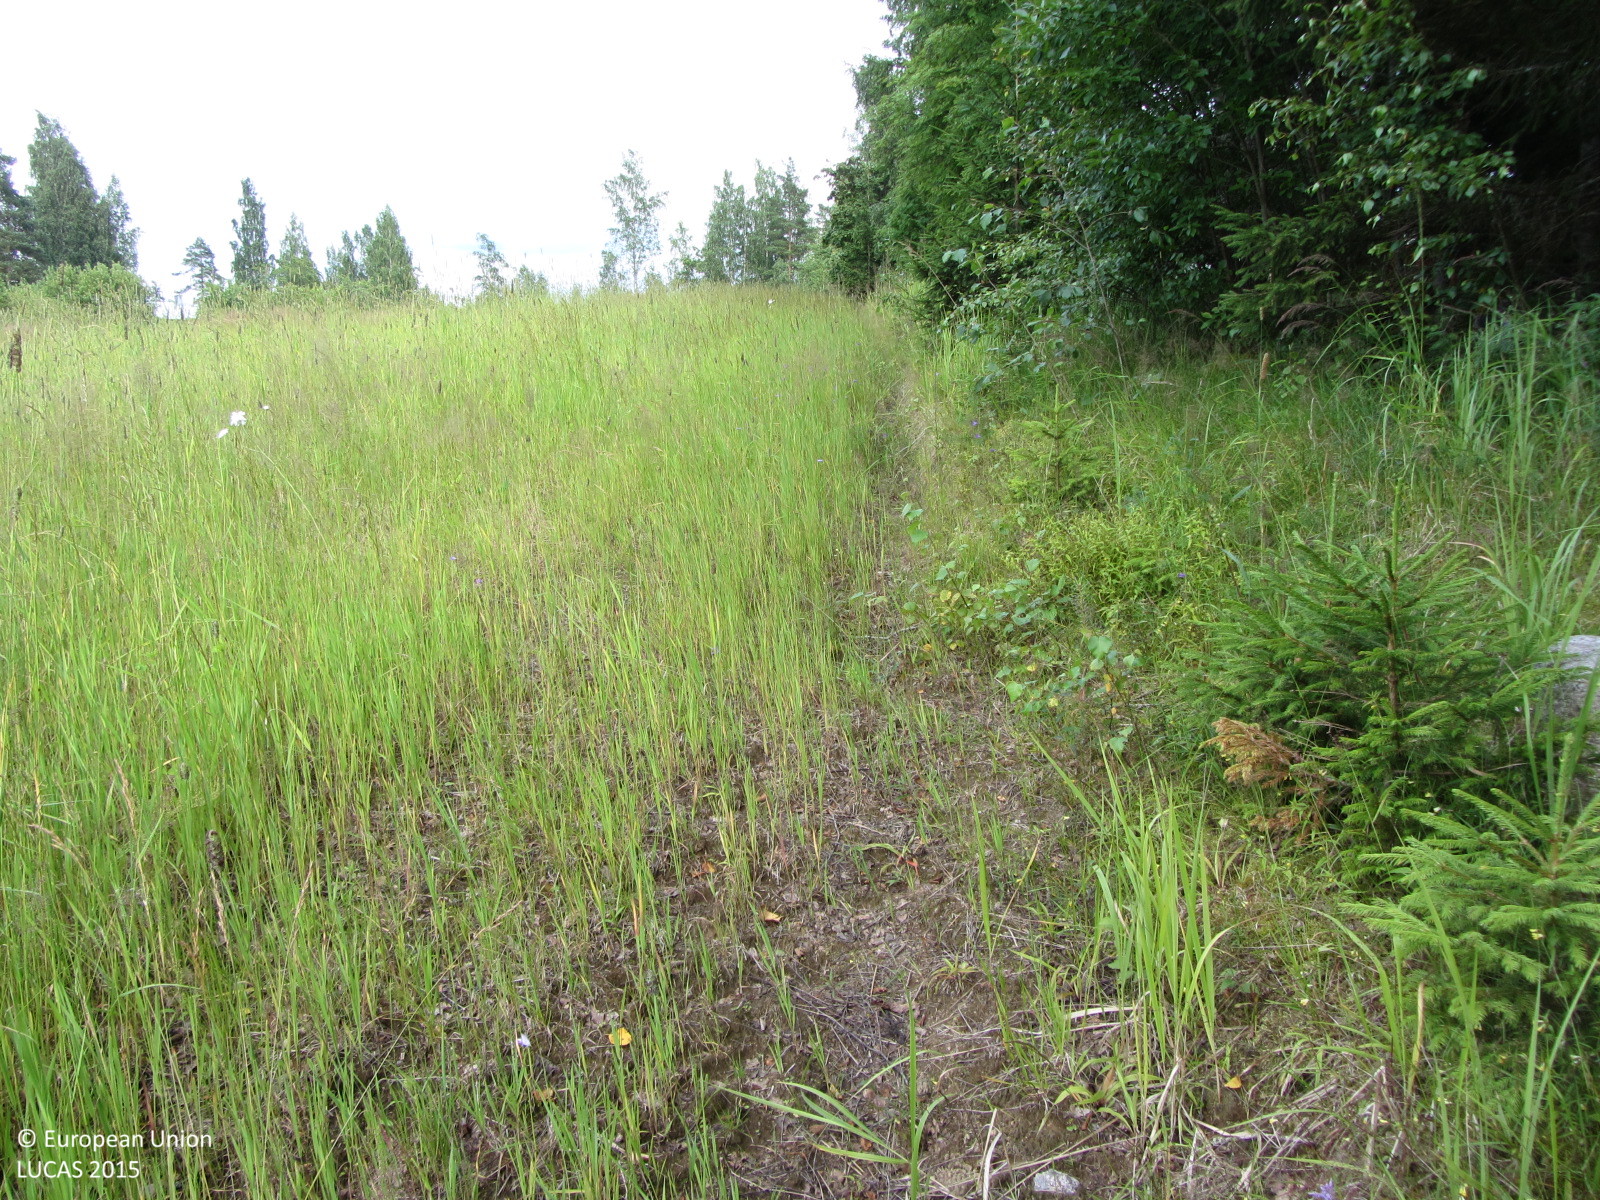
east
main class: Grassland
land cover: Grassland without tree/shrub cover
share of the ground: > 75 %
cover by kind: herbaceous plants 100 %
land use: Agriculture (excluding fallow land and kitchen gardens)
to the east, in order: Grassland without tree/shrub cover; Broadleaved woodland; Artificial constructions in urban areas; Pine dominated mixed woodland; Ditches and canals; Grass margins; Tracks; Pine dominated mixed woodland
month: July
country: FI
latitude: 60.6451
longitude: 24.4225
